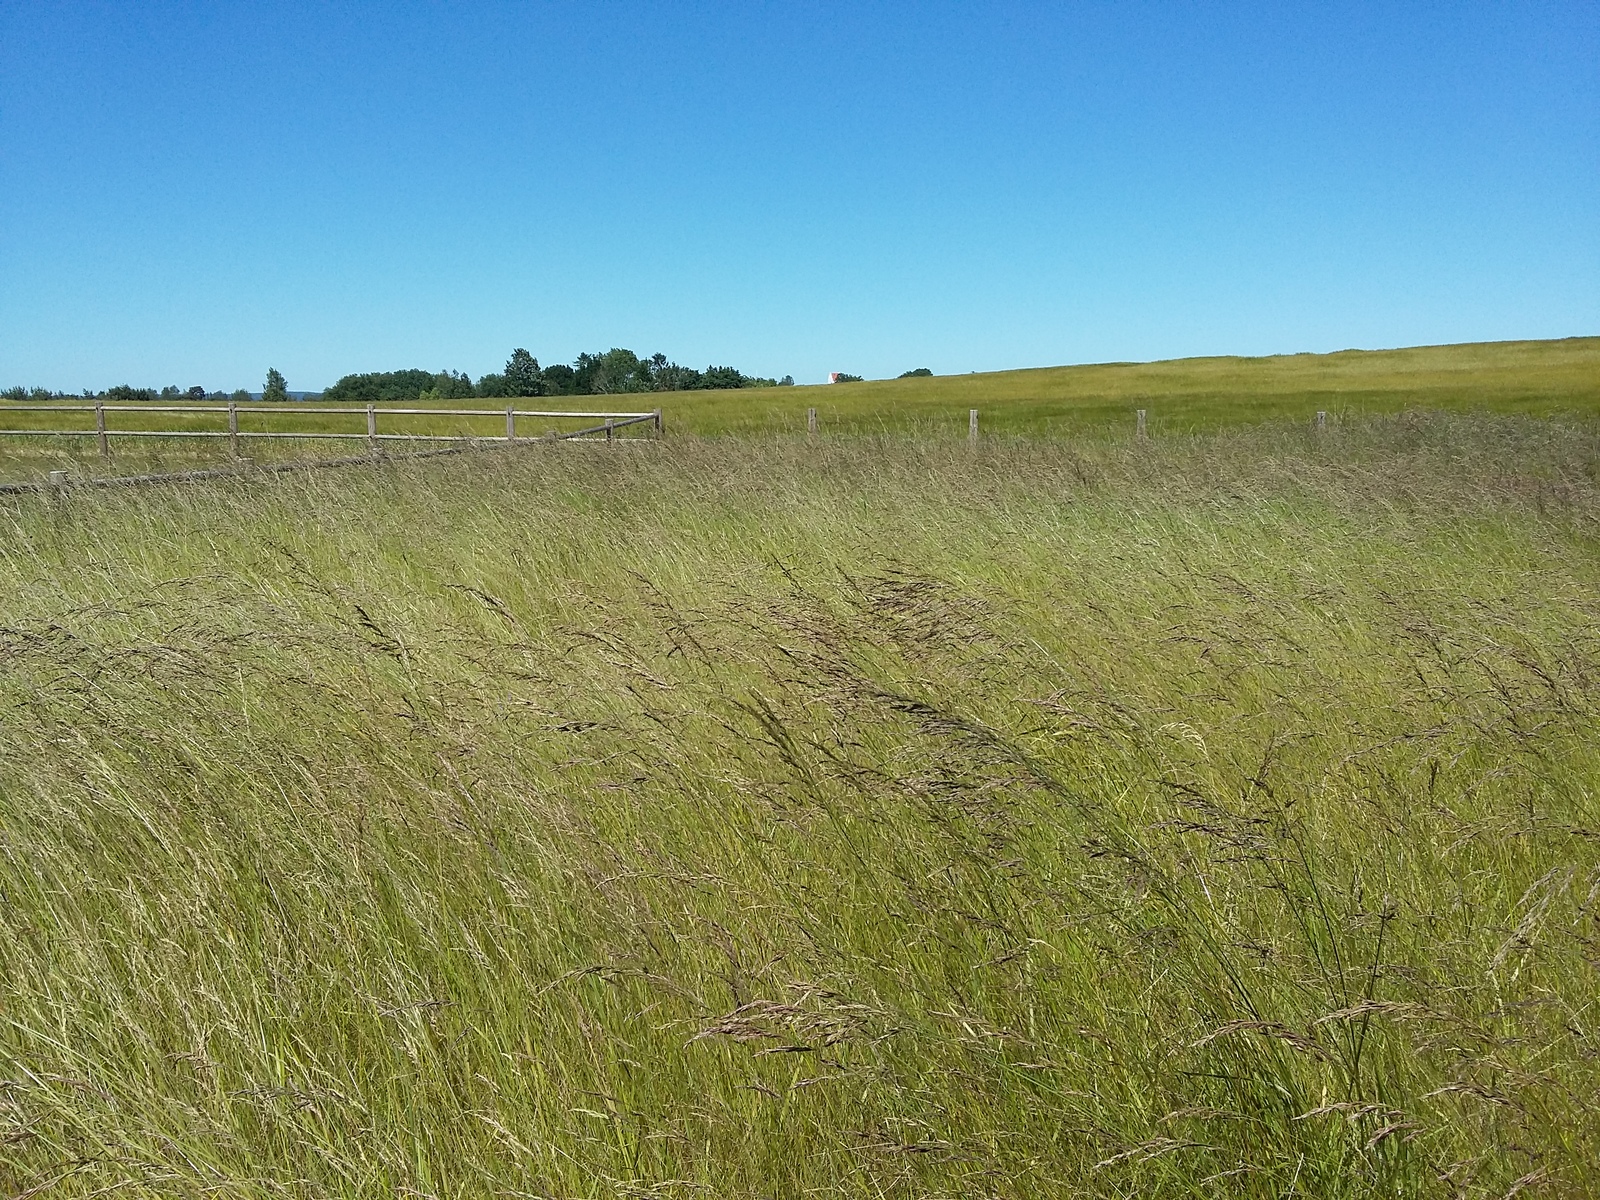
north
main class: Grassland
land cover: Grassland without tree/shrub cover
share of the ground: > 75 %
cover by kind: herbaceous plants 100 %
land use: Agriculture (excluding fallow land and kitchen gardens)
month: July
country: DK
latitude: 55.0930
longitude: 12.0199
